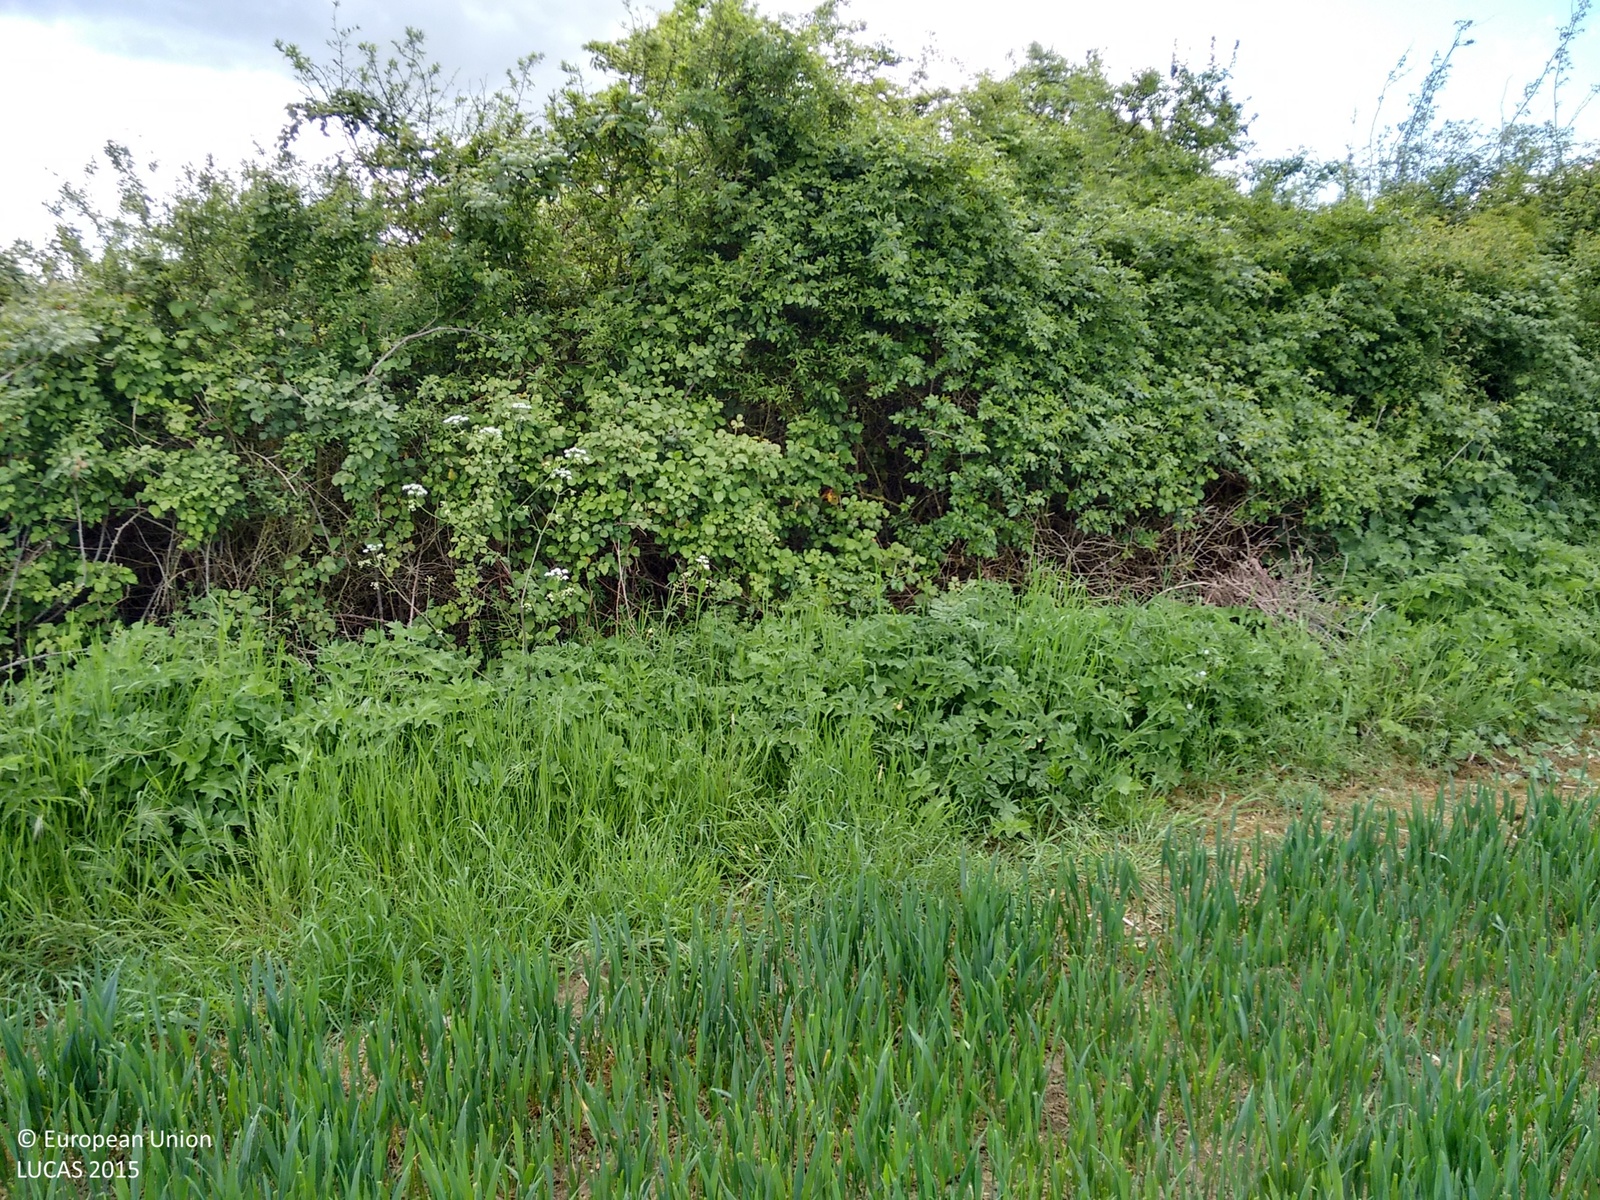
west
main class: Cropland
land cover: Common wheat
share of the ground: > 75 %
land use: Agriculture (excluding fallow land and kitchen gardens)
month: May
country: GB
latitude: 52.0763
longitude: -0.4703
